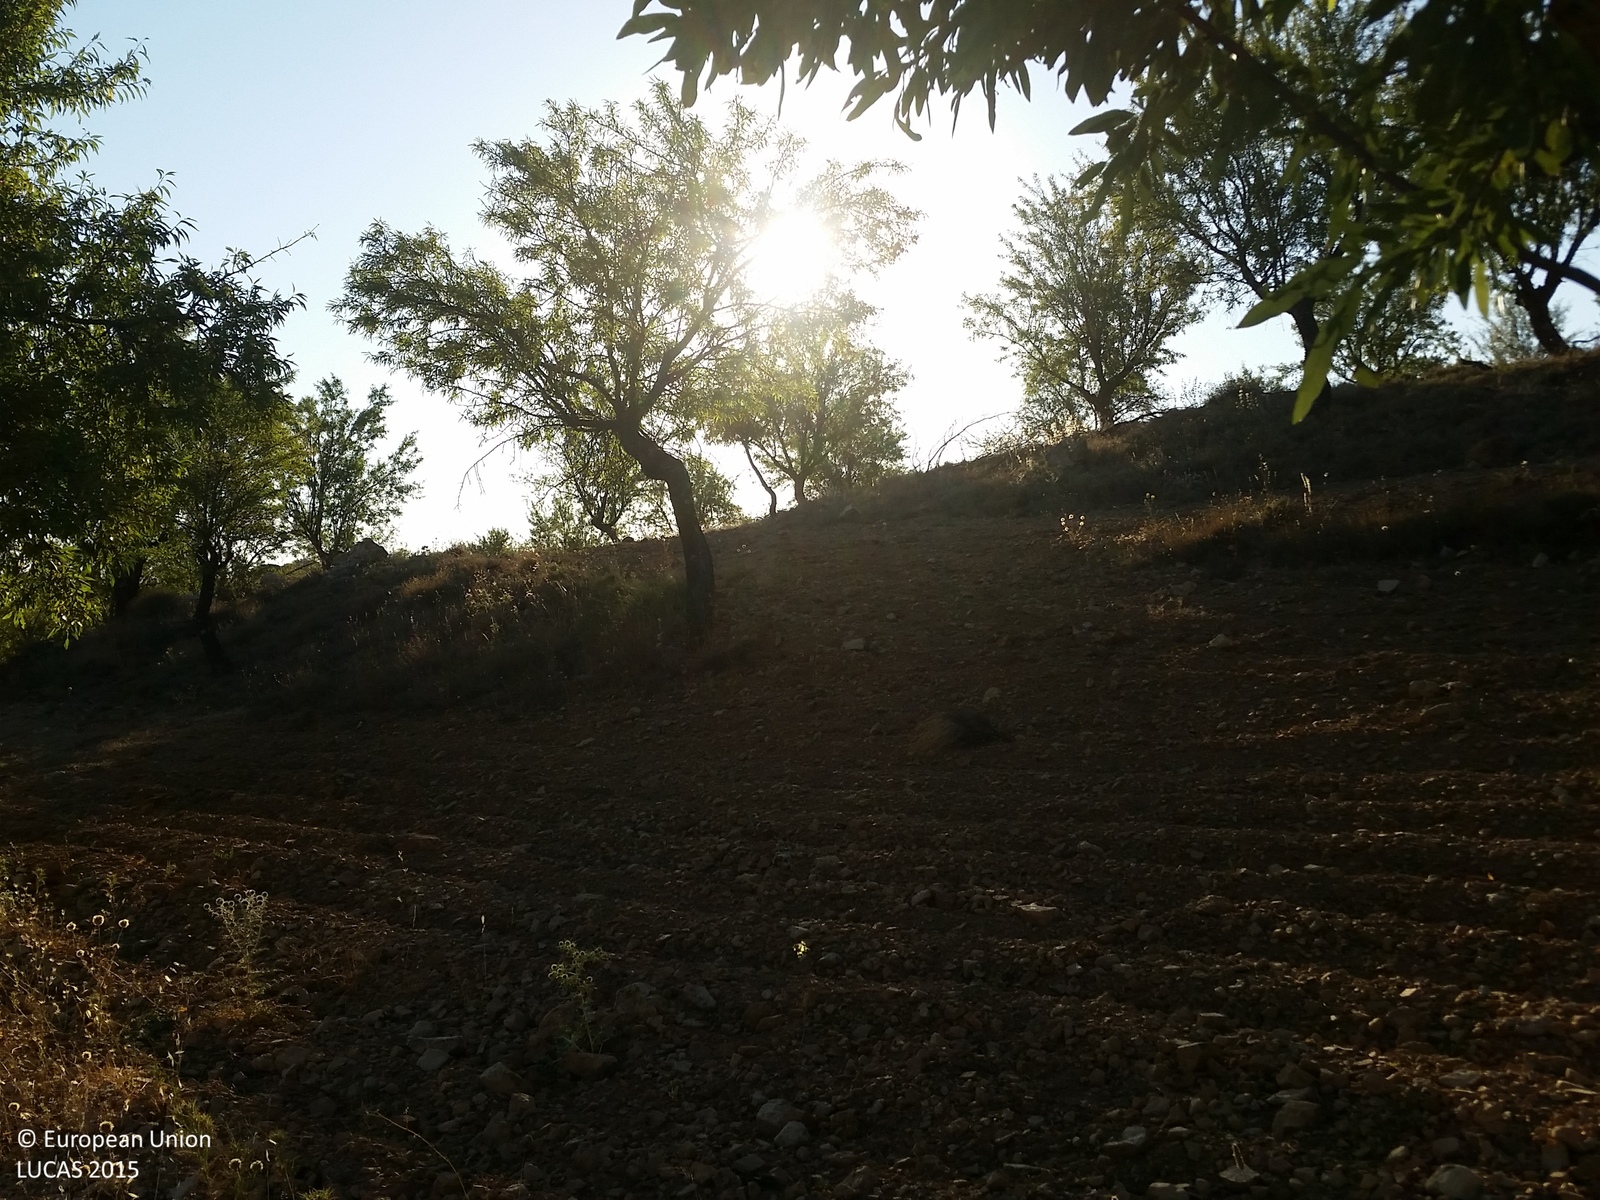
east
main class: Cropland
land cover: Nuts trees
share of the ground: > 75 %
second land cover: Grassland without tree/shrub cover
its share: 25 - 50 %
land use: Agriculture (excluding fallow land and kitchen gardens)
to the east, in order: Nuts trees; Grassland without tree/shrub cover; Grass margins; Common wheat; Permanent industrial crops
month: July
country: ES
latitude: 38.9669
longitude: -2.5278
